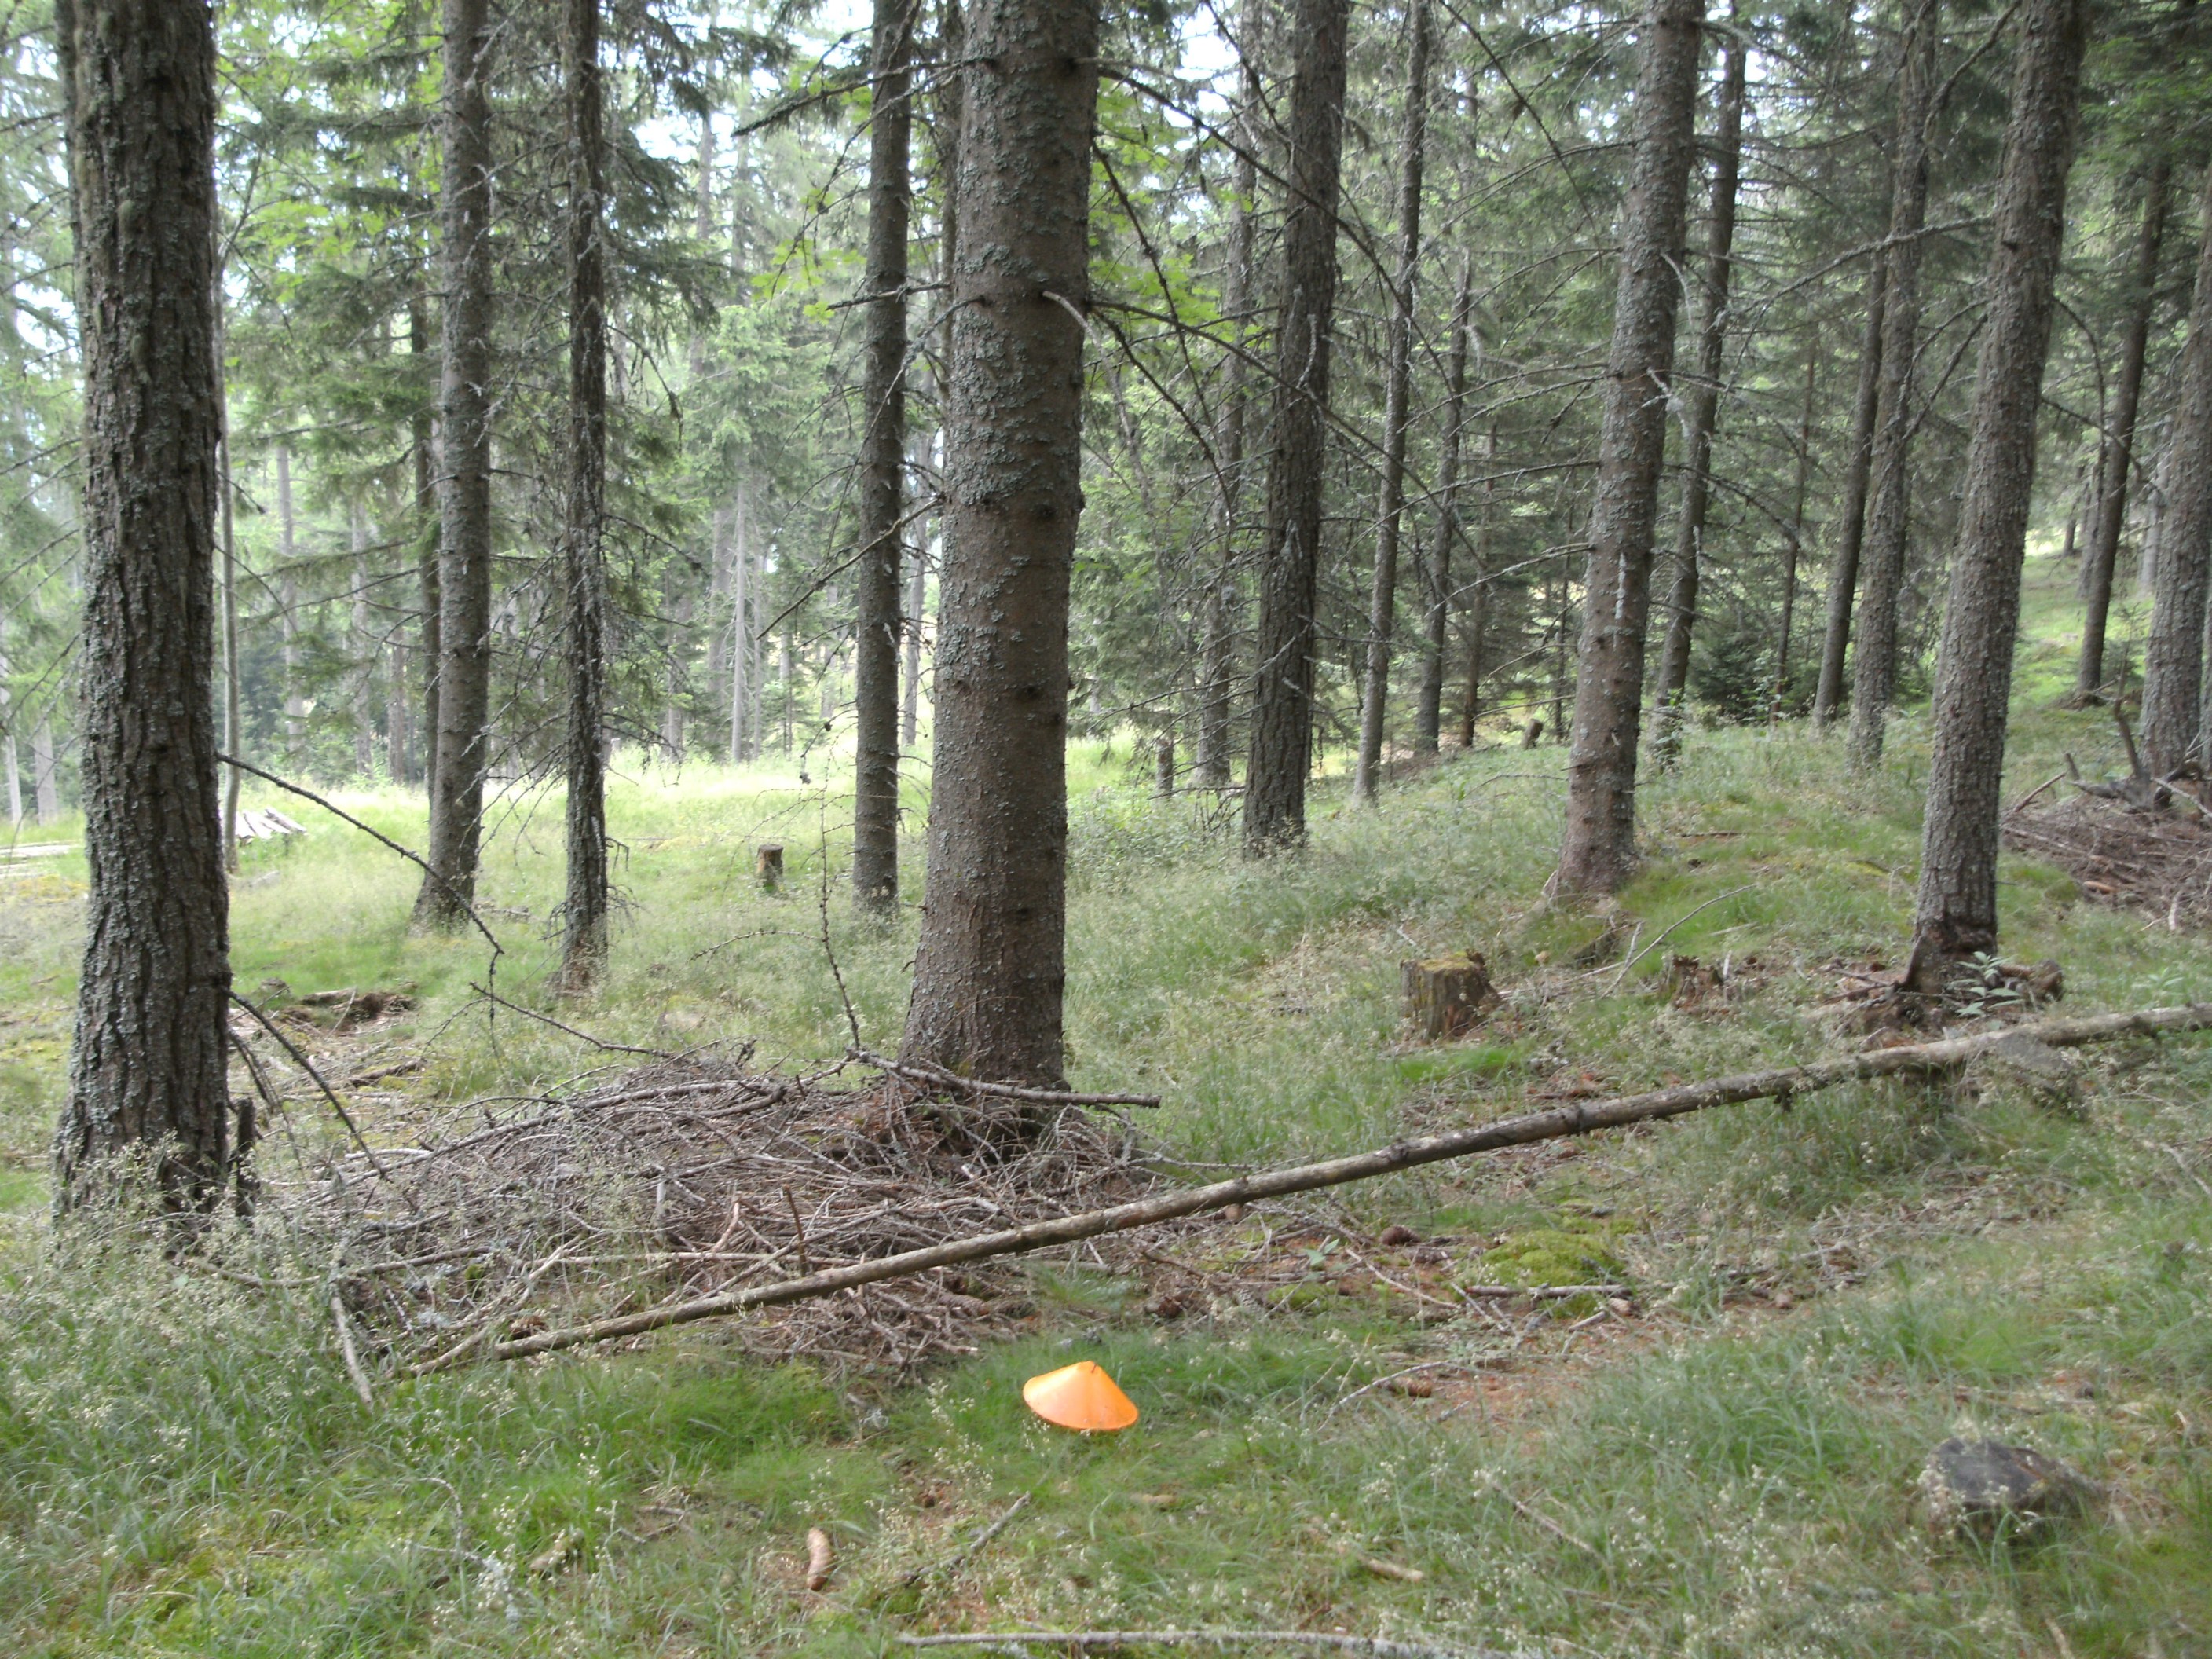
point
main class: Woodland
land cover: Other coniferous woodland
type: alpine coniferous forest
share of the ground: 50 - 75 %
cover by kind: coniferous forest trees 75 %, shrubs 20 %, unconsolidated bare surface 5 %
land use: Forestry
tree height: > 5 m
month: July
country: AT
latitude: 46.9676
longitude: 14.7432
